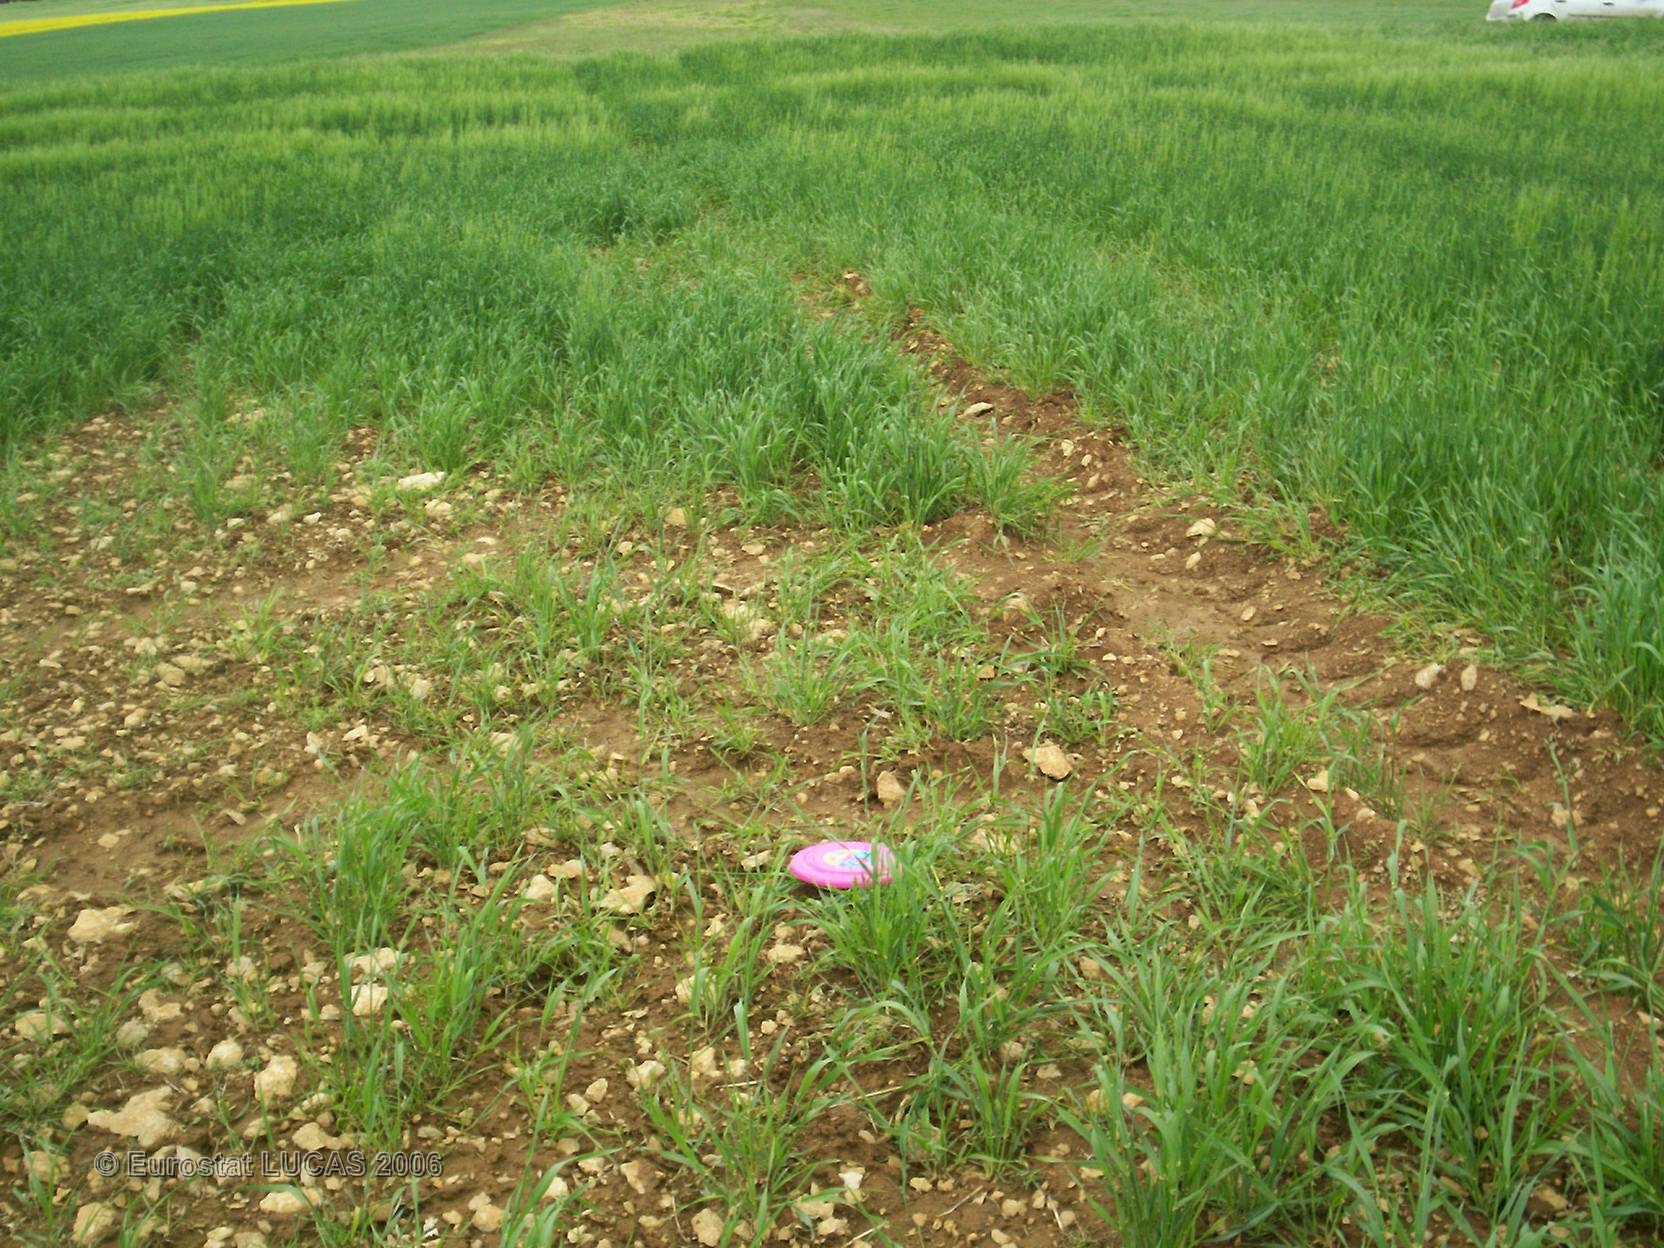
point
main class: Cropland
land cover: Barley
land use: Agriculture (excluding fallow land and kitchen gardens)
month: May
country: FR
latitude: 46.9740
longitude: 4.6243
